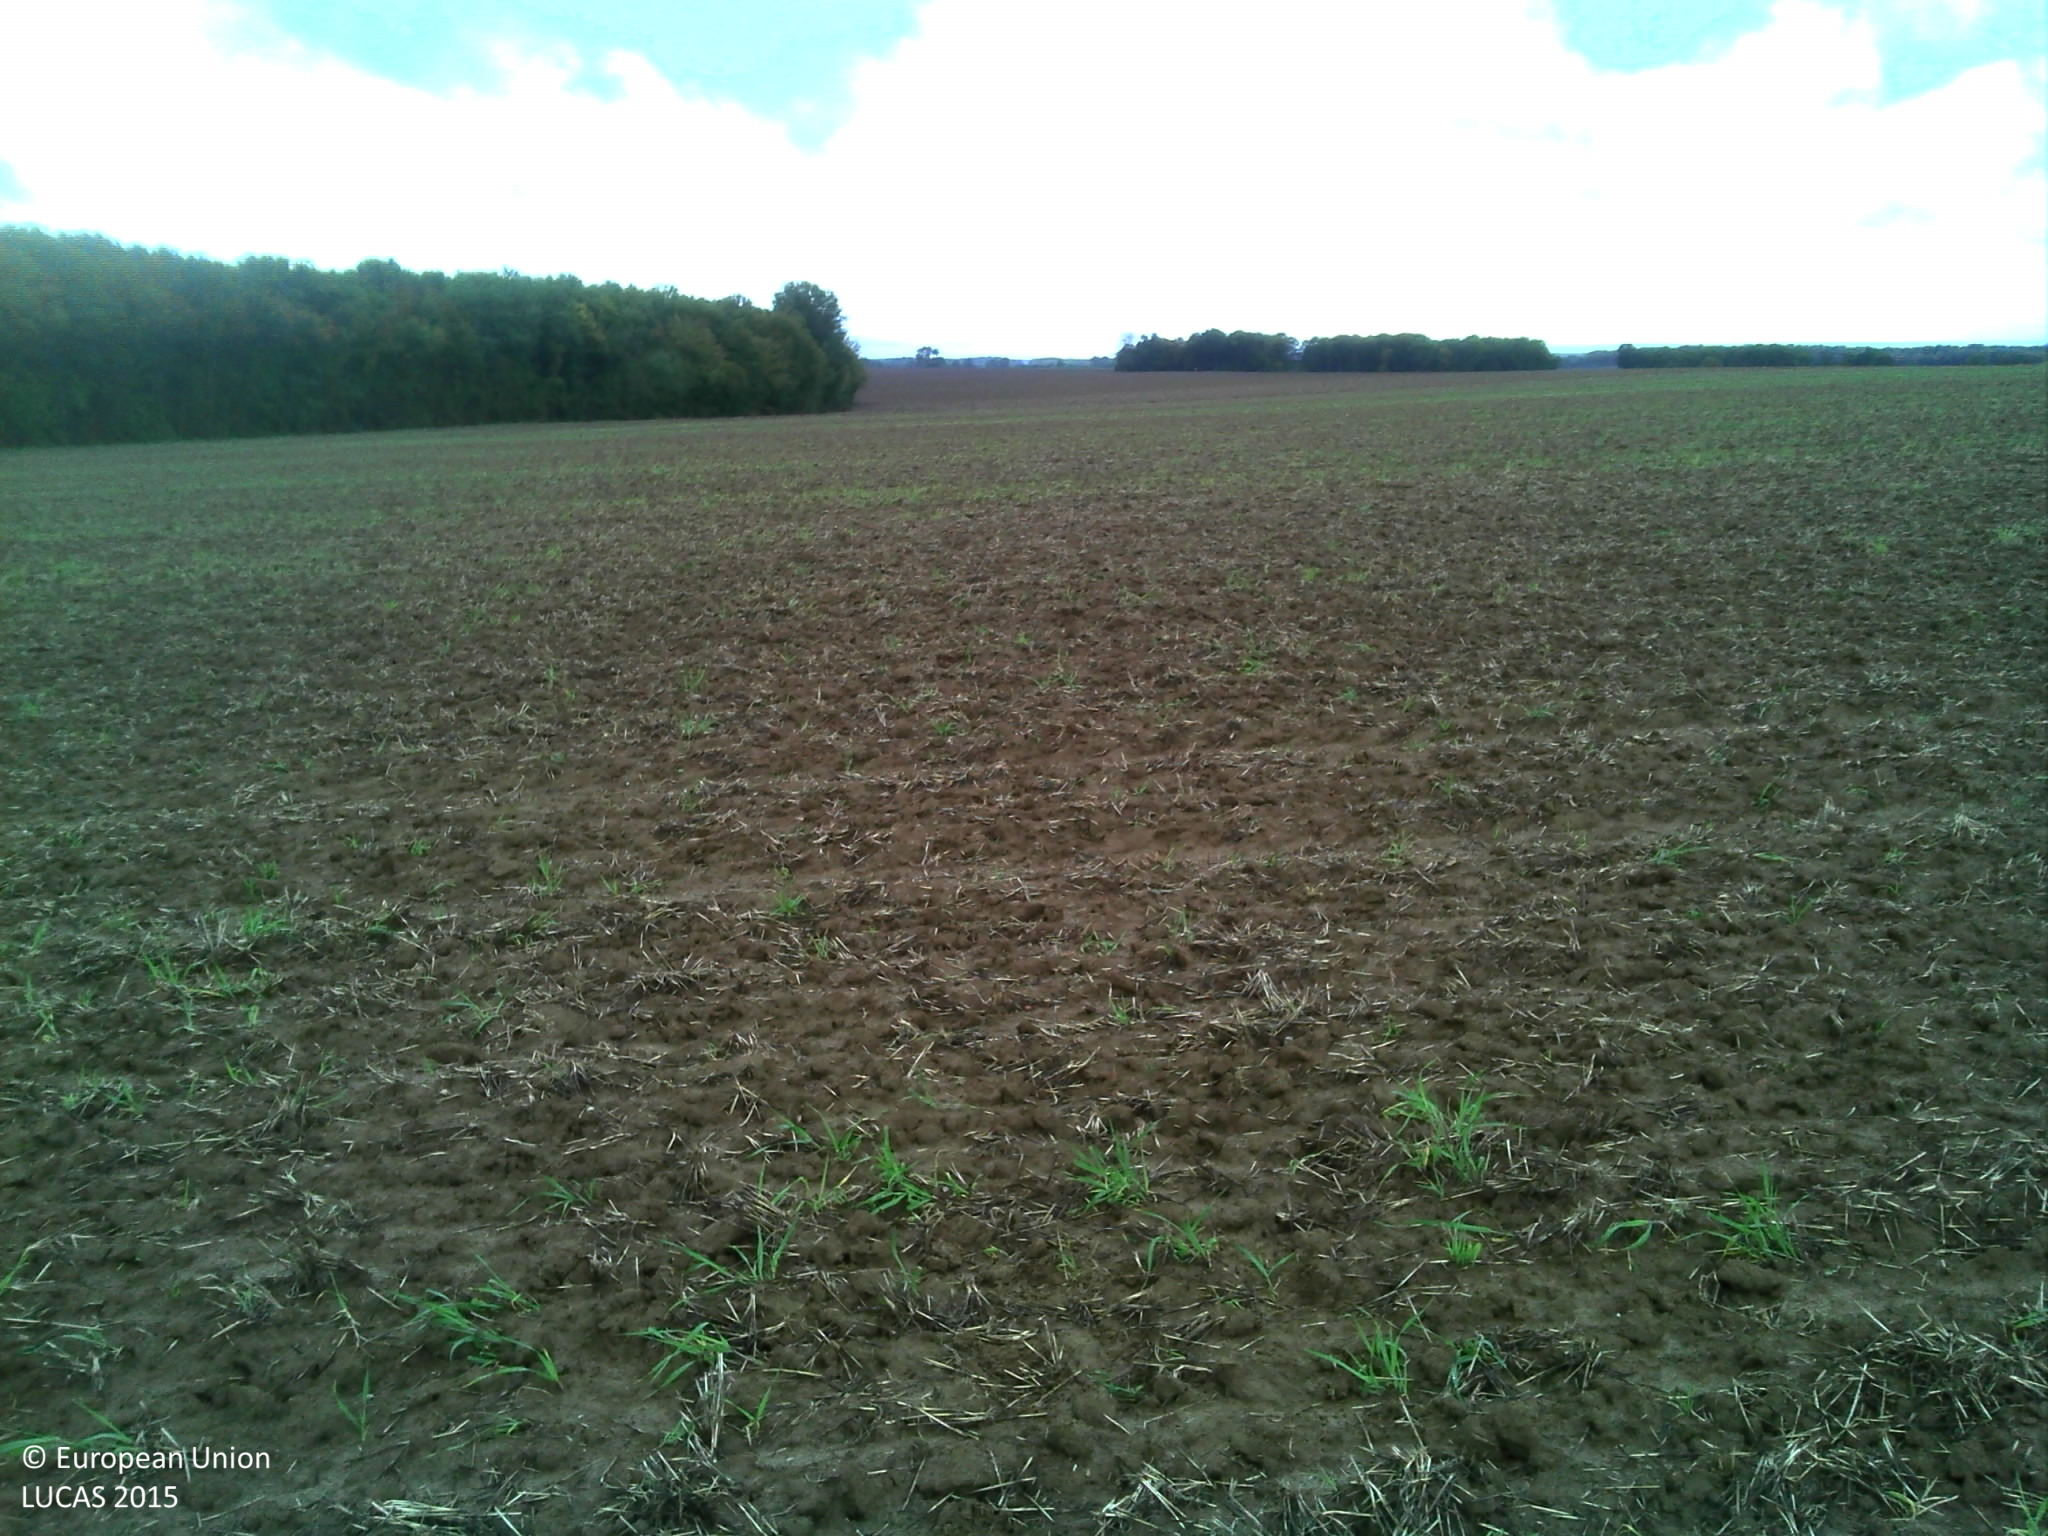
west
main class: Cropland
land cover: Common wheat
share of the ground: 25 - 50 %
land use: Agriculture (excluding fallow land and kitchen gardens)
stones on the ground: < 10 %
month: October
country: FR
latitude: 48.2923
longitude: 4.2955
